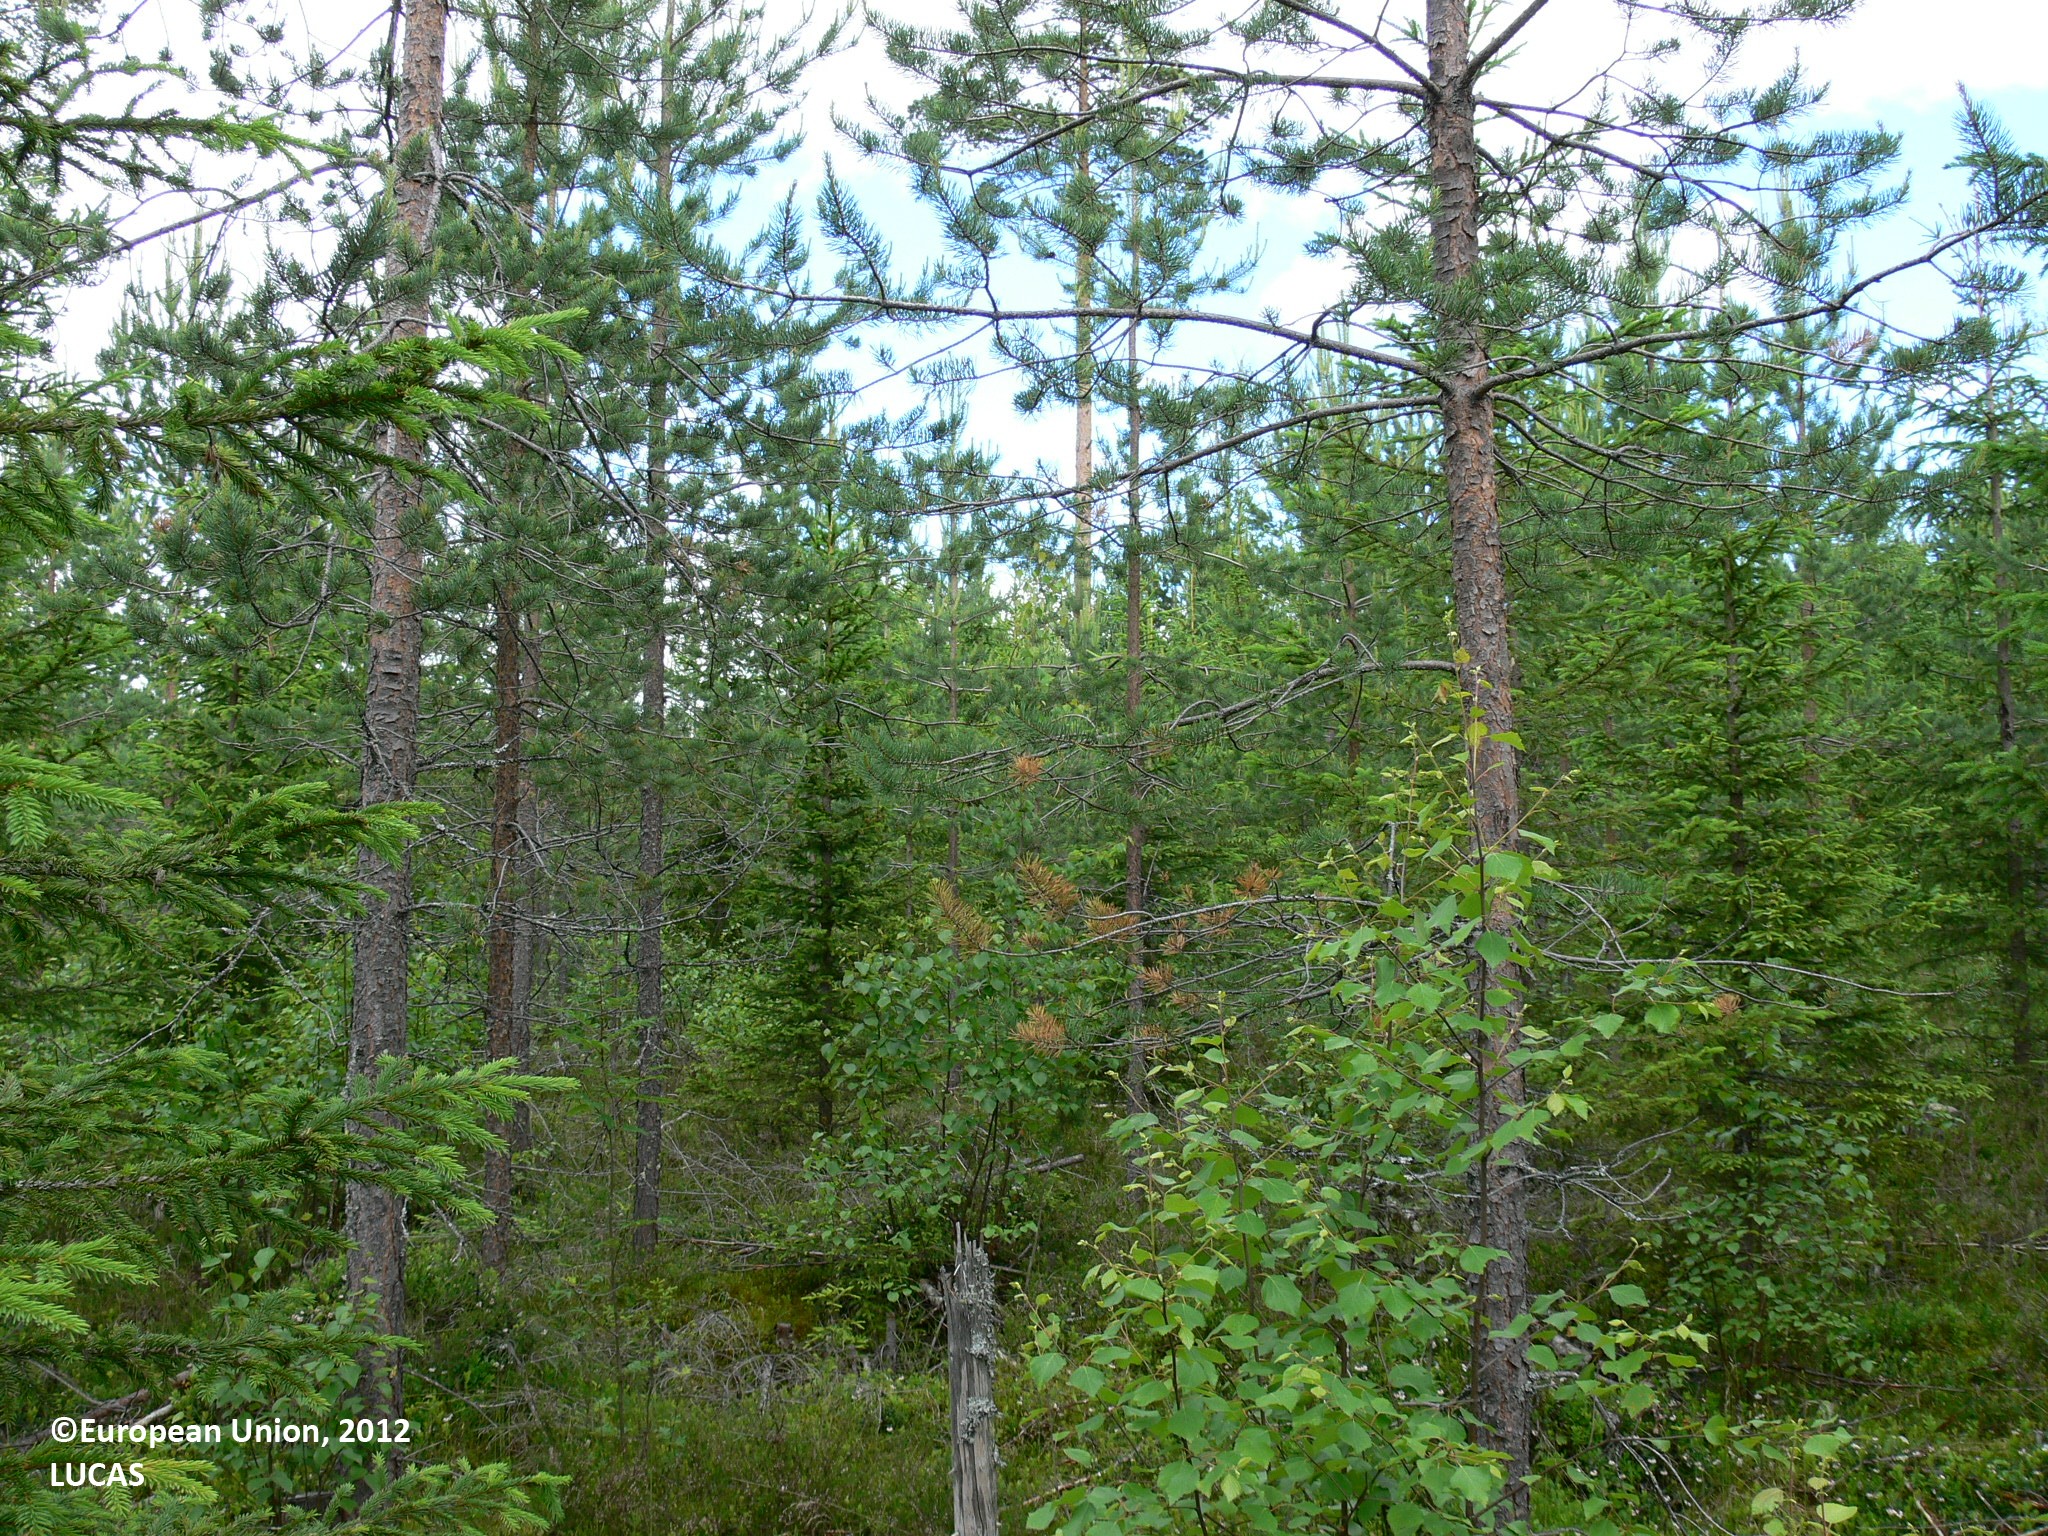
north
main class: Woodland
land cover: Other coniferous woodland
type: boreal forest
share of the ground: > 75 %
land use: Forestry
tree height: < 5 m
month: June
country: FI
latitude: 62.7302
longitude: 30.6522
